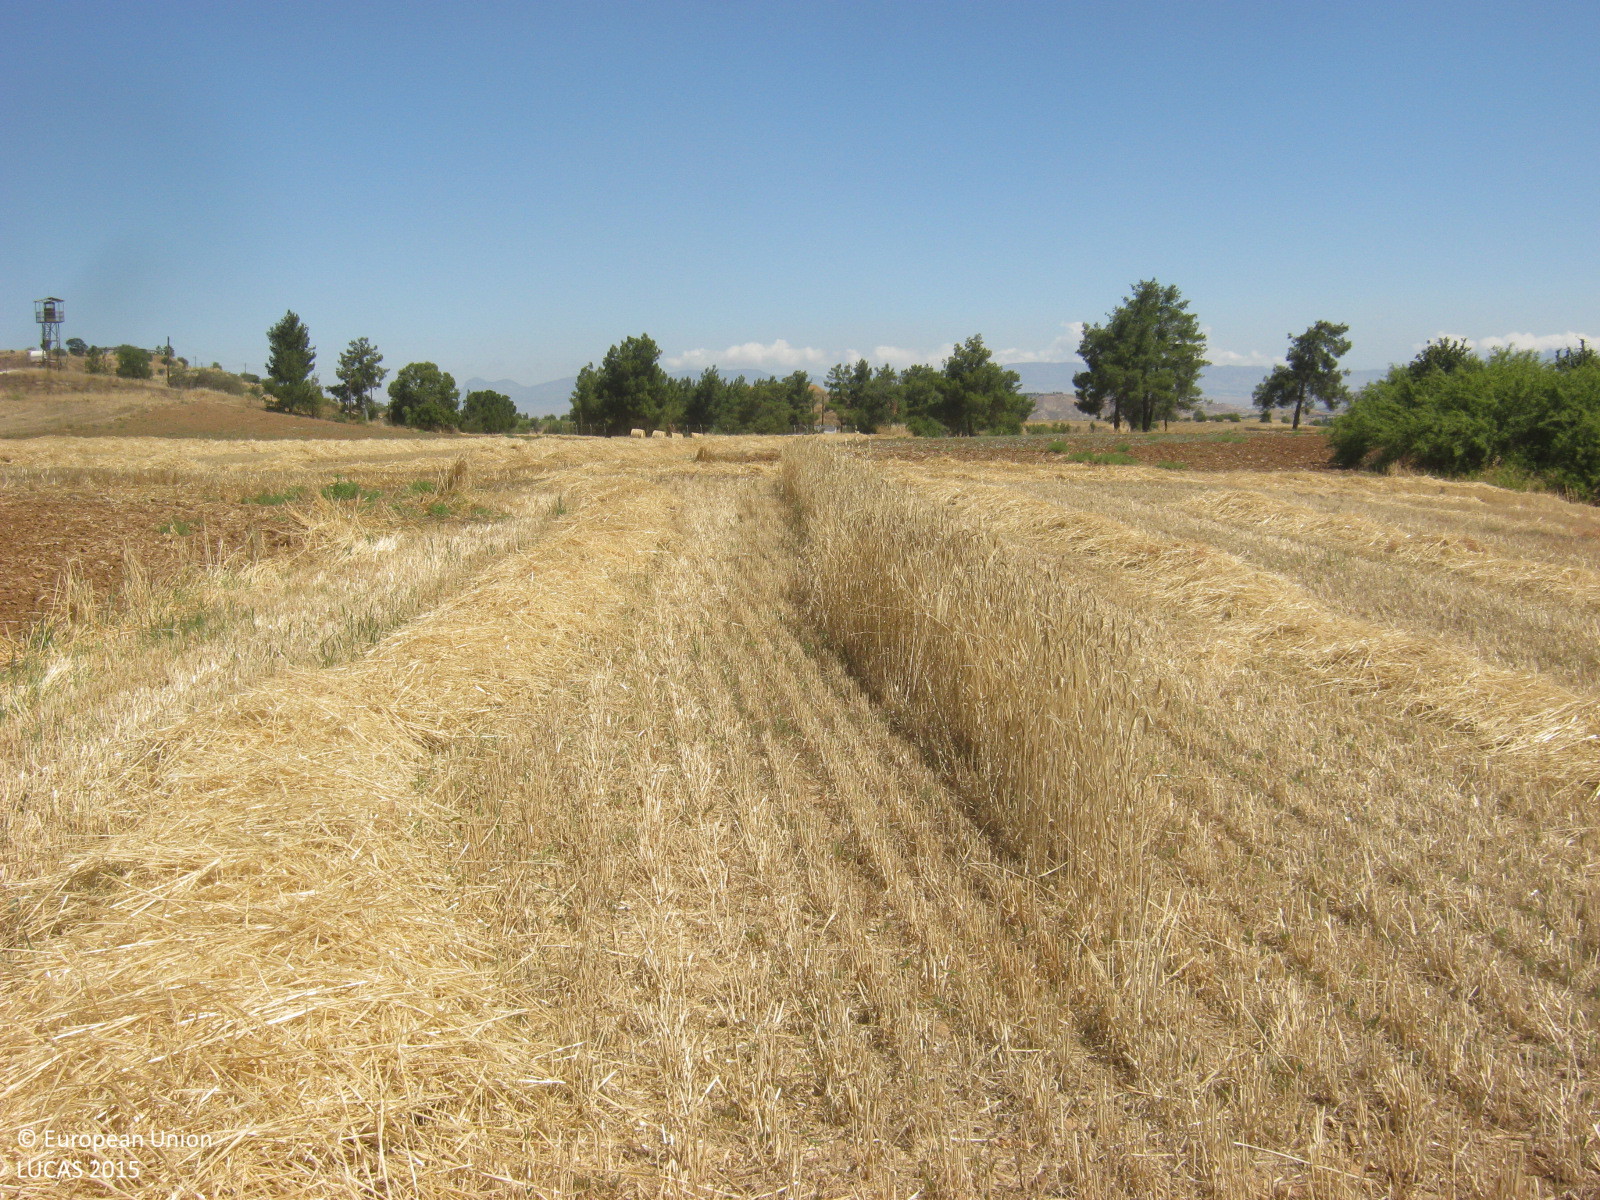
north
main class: Cropland
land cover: Barley
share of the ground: < 10 %
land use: Agriculture (excluding fallow land and kitchen gardens)
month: June
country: CY
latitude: 35.0271
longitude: 33.1880
